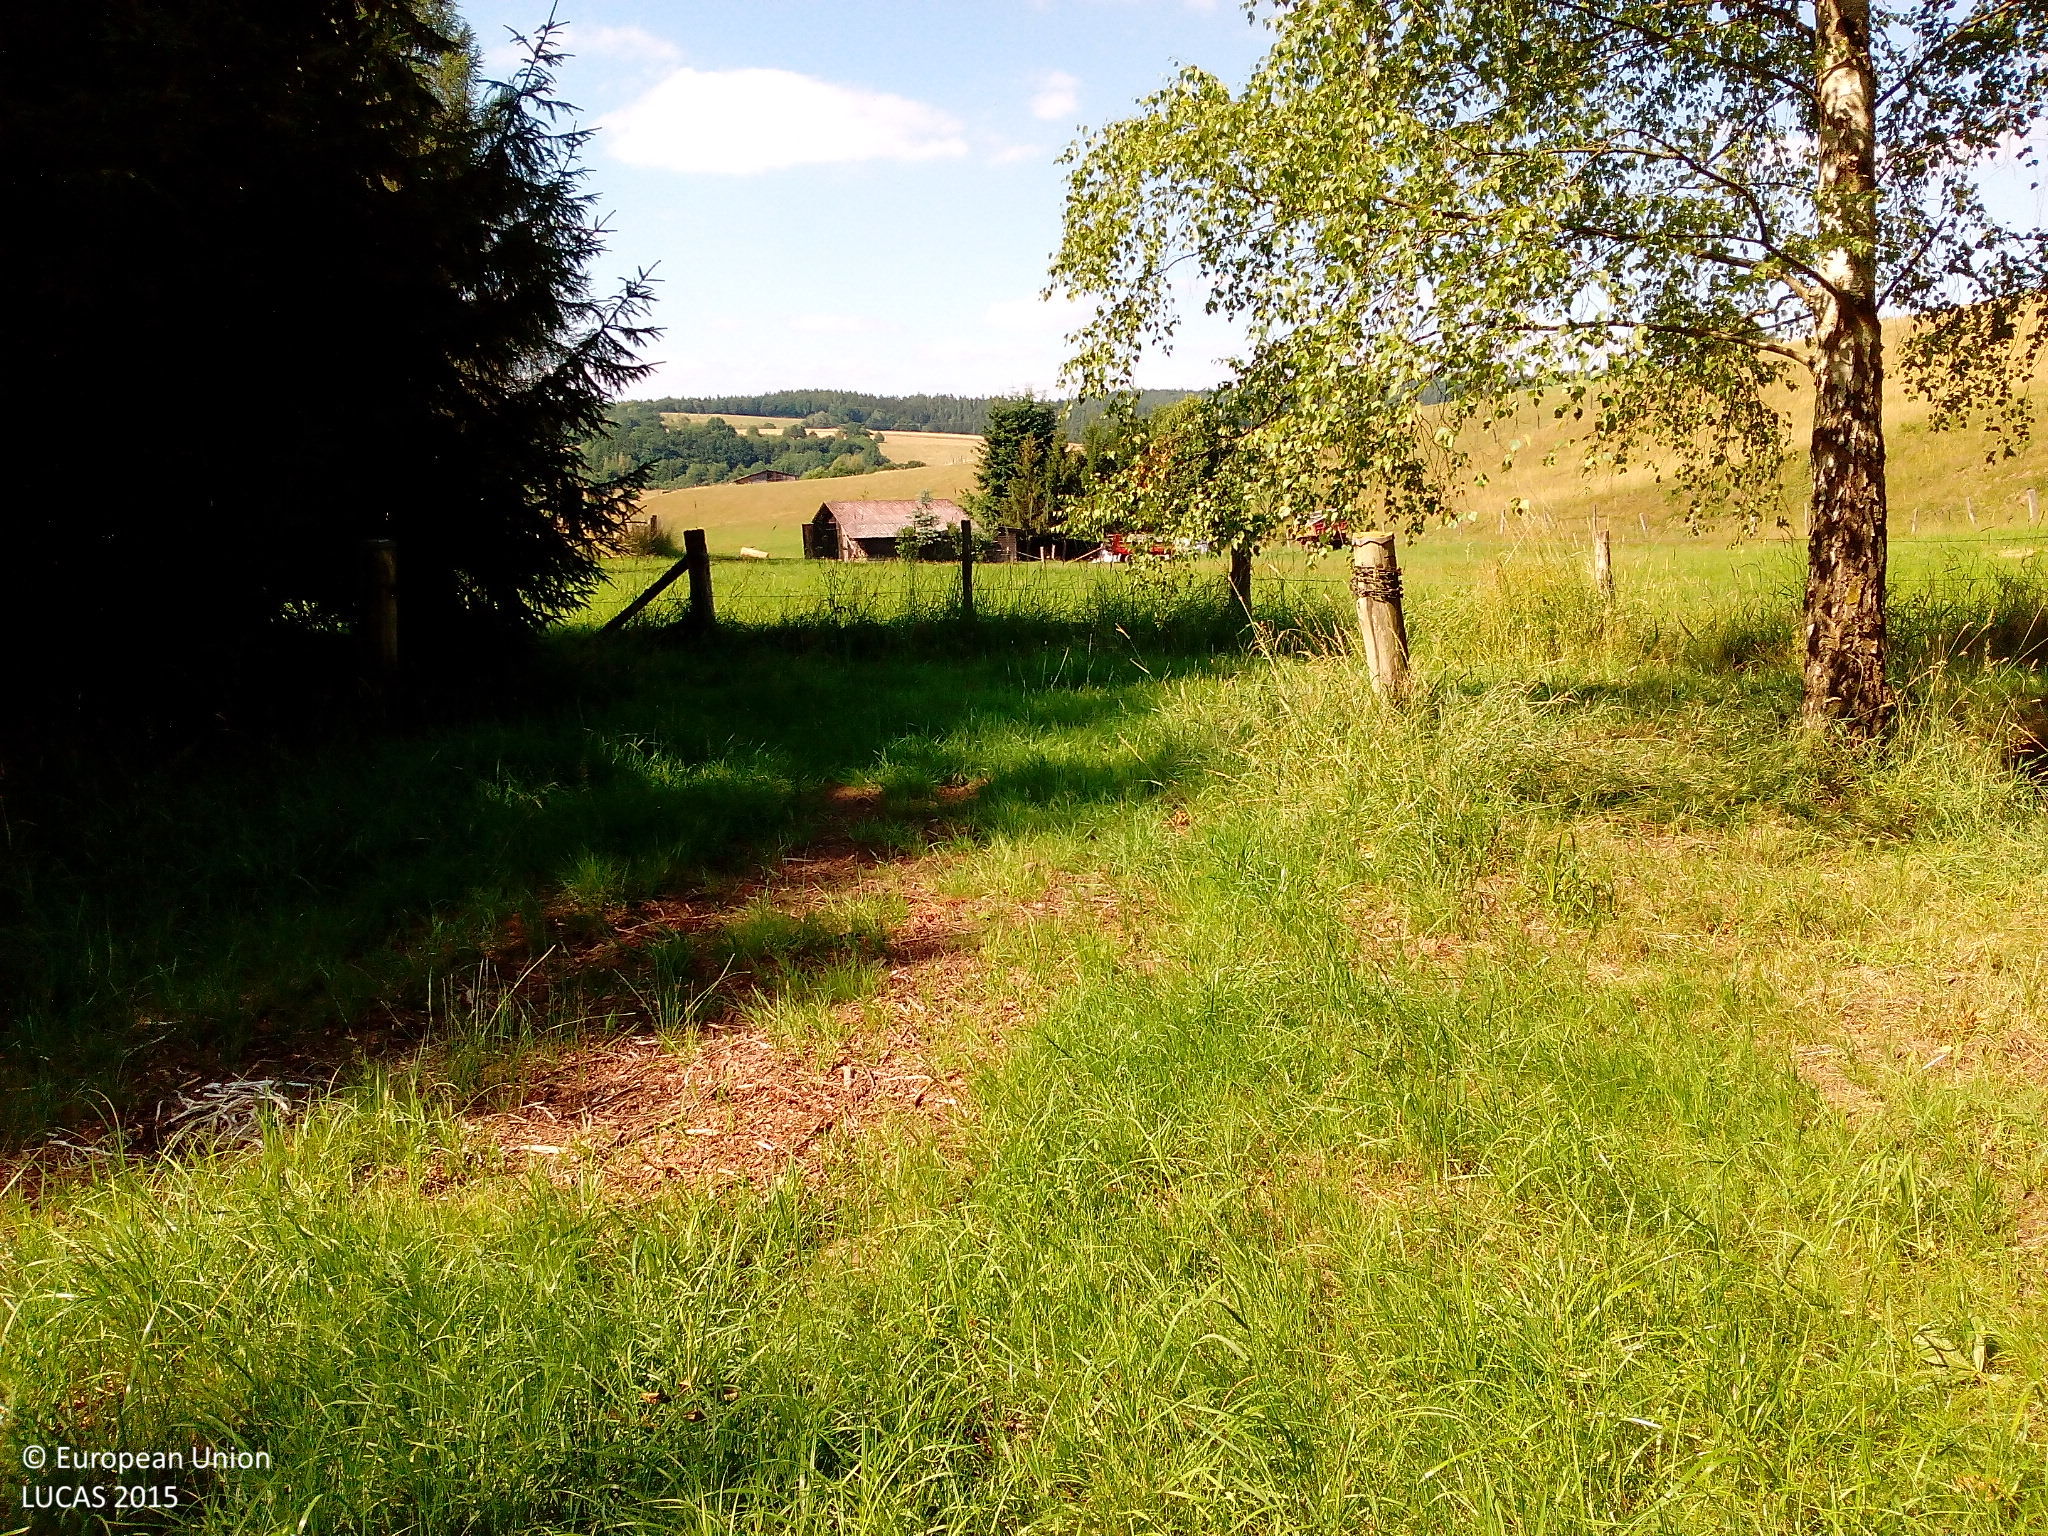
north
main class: Grassland
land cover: Grassland without tree/shrub cover
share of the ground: > 75 %
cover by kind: herbaceous plants 100 %
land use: Agriculture (excluding fallow land and kitchen gardens)
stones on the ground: < 10 %
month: July
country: DE
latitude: 50.9393
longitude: 9.8720
